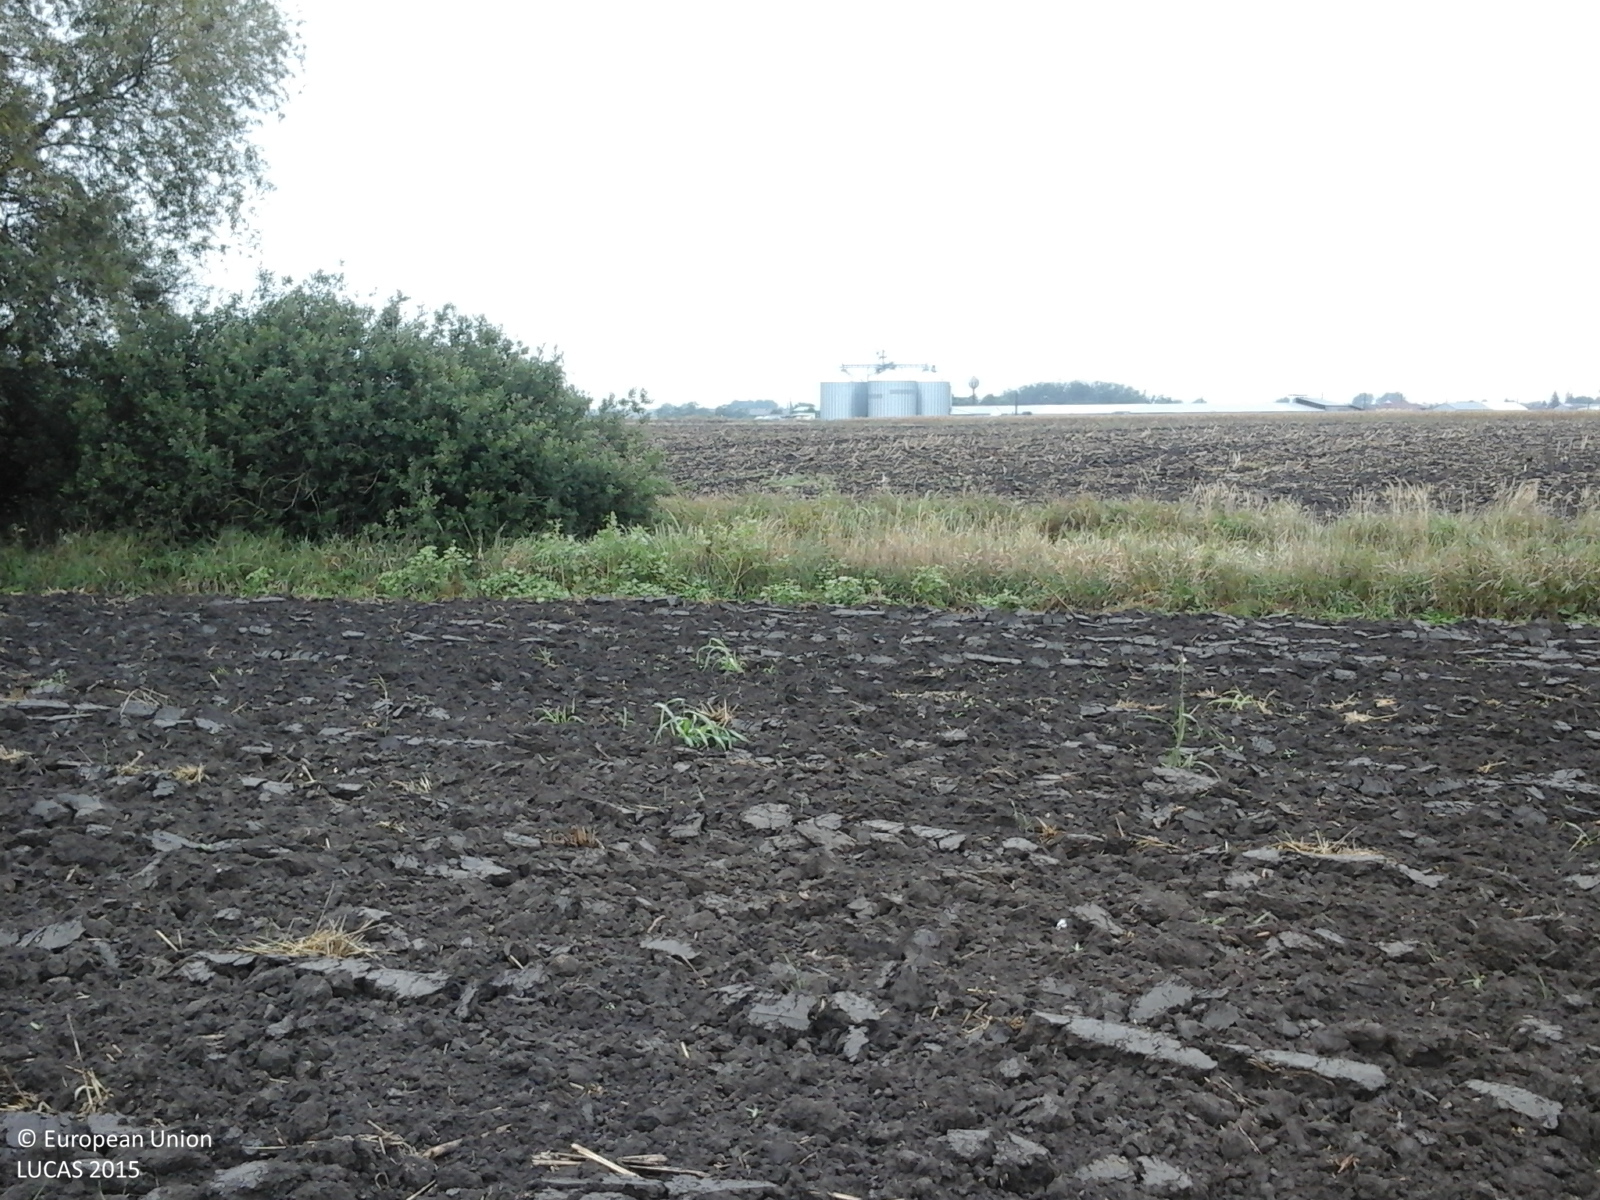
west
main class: Cropland
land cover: Common wheat
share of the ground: < 10 %
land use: Agriculture (excluding fallow land and kitchen gardens)
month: September
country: RO
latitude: 47.4533
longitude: 22.1882
